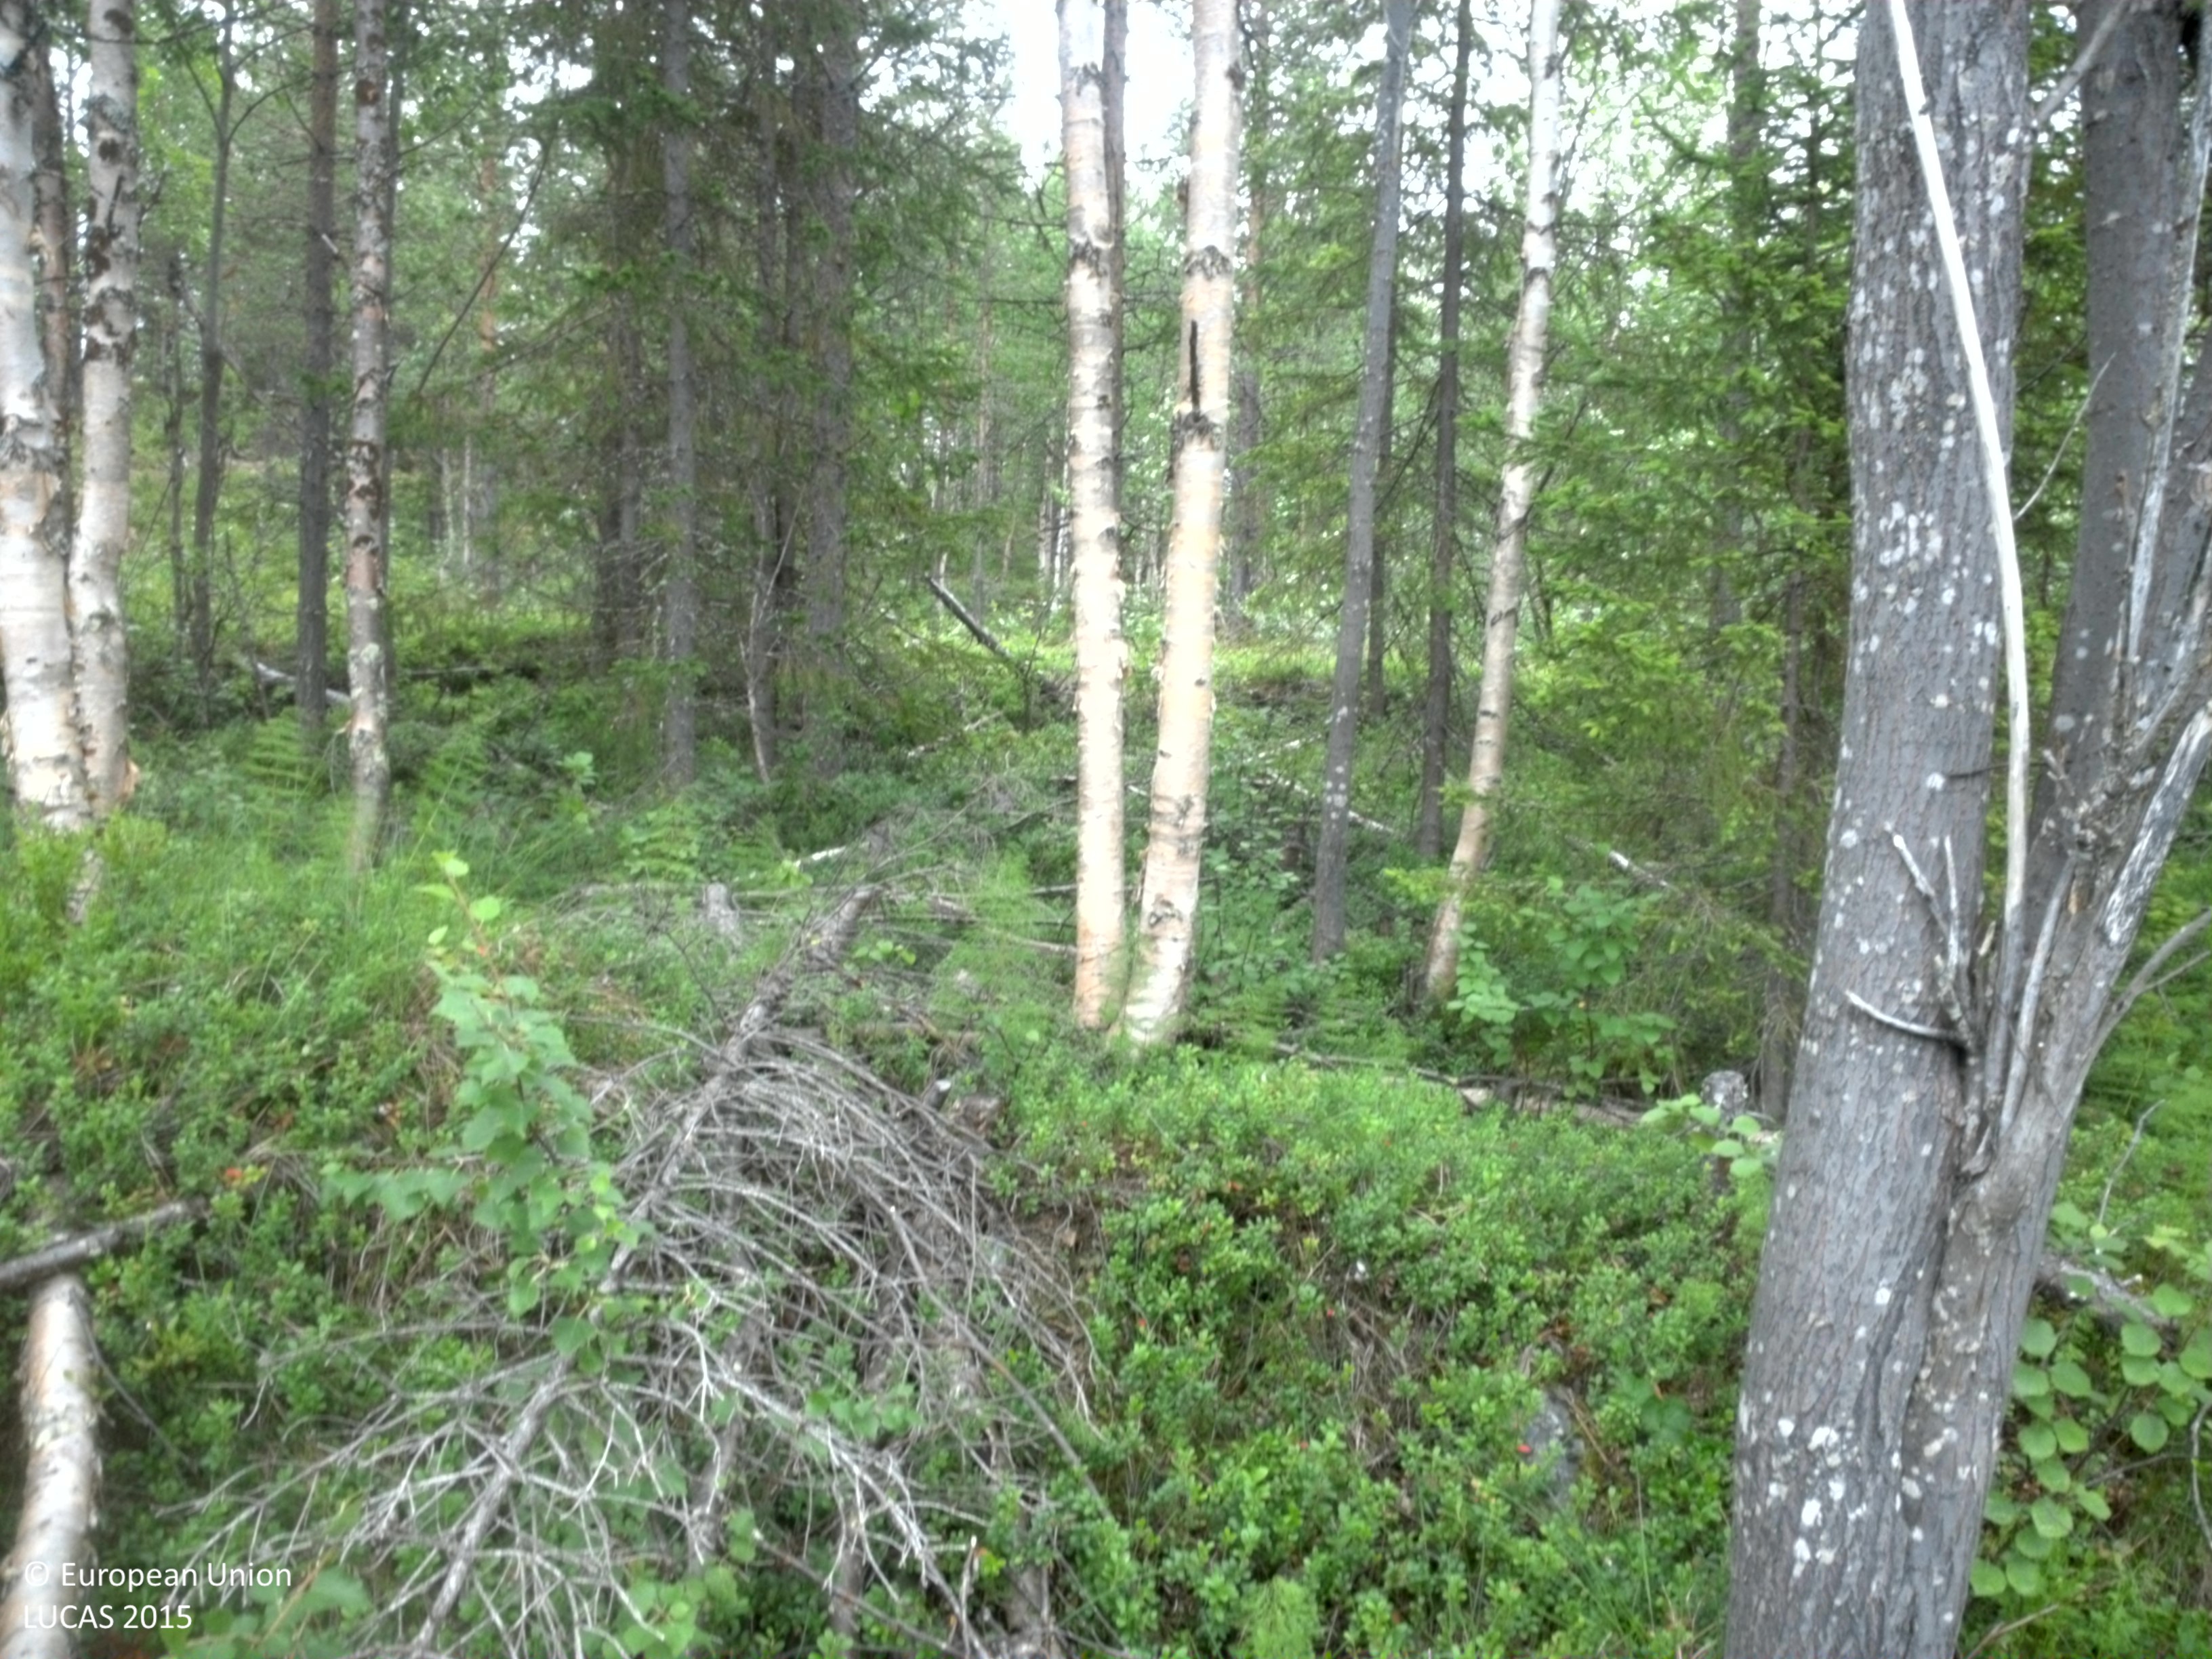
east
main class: Woodland
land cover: Pine dominated mixed woodland
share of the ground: 25 - 50 %
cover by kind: shrubs 50 %, broadleaved forest trees 30 %, coniferous forest trees 20 %
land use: Forestry
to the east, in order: Pine dominated mixed woodland; Tracks; Broadleaved woodland; Pine dominated mixed woodland; Broadleaved woodland; Peatbogs; Pine dominated mixed woodland; Peatbogs; Inland fresh water bodies
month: August
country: SE
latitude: 66.1875
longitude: 19.8786
